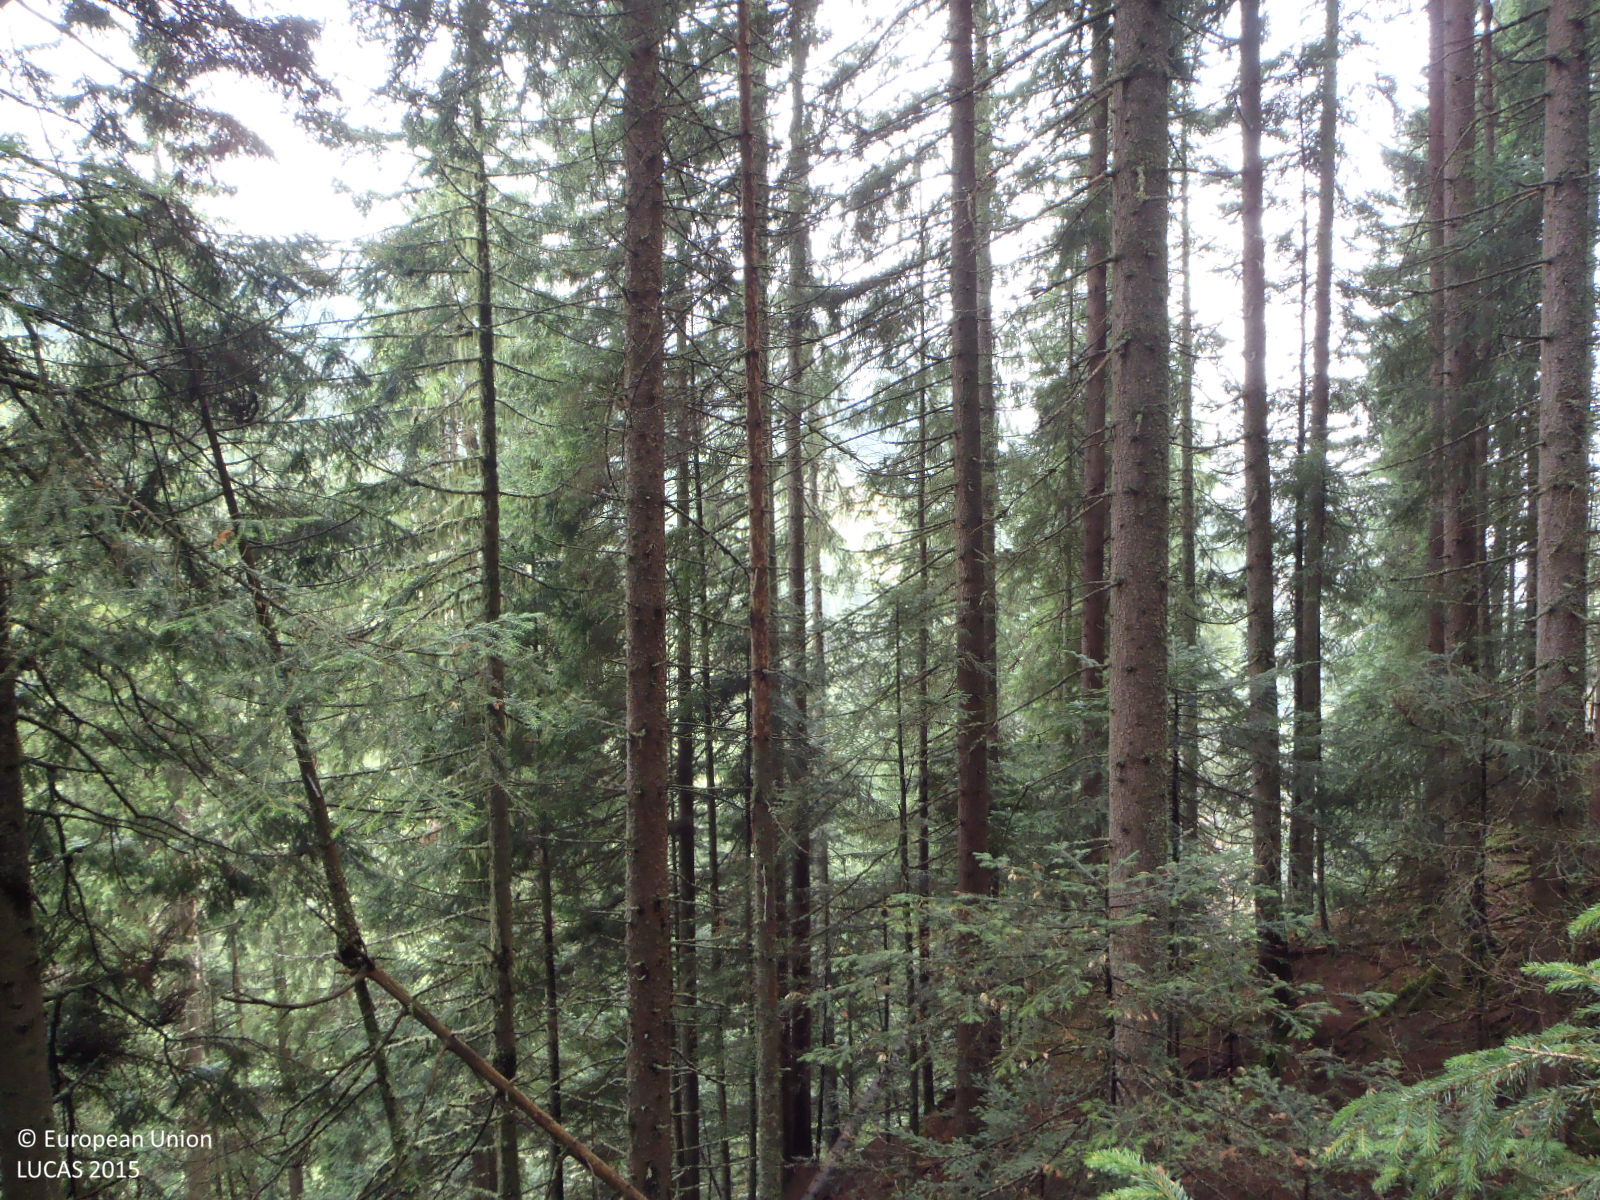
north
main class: Woodland
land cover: Spruce dominated coniferous woodland
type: alpine coniferous forest
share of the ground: > 75 %
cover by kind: coniferous forest trees 80 %, herbaceous plants 10 %, lichens and mosses 10 %
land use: Forestry
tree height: > 5 m
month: July
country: AT
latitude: 47.2901
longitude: 11.8364
